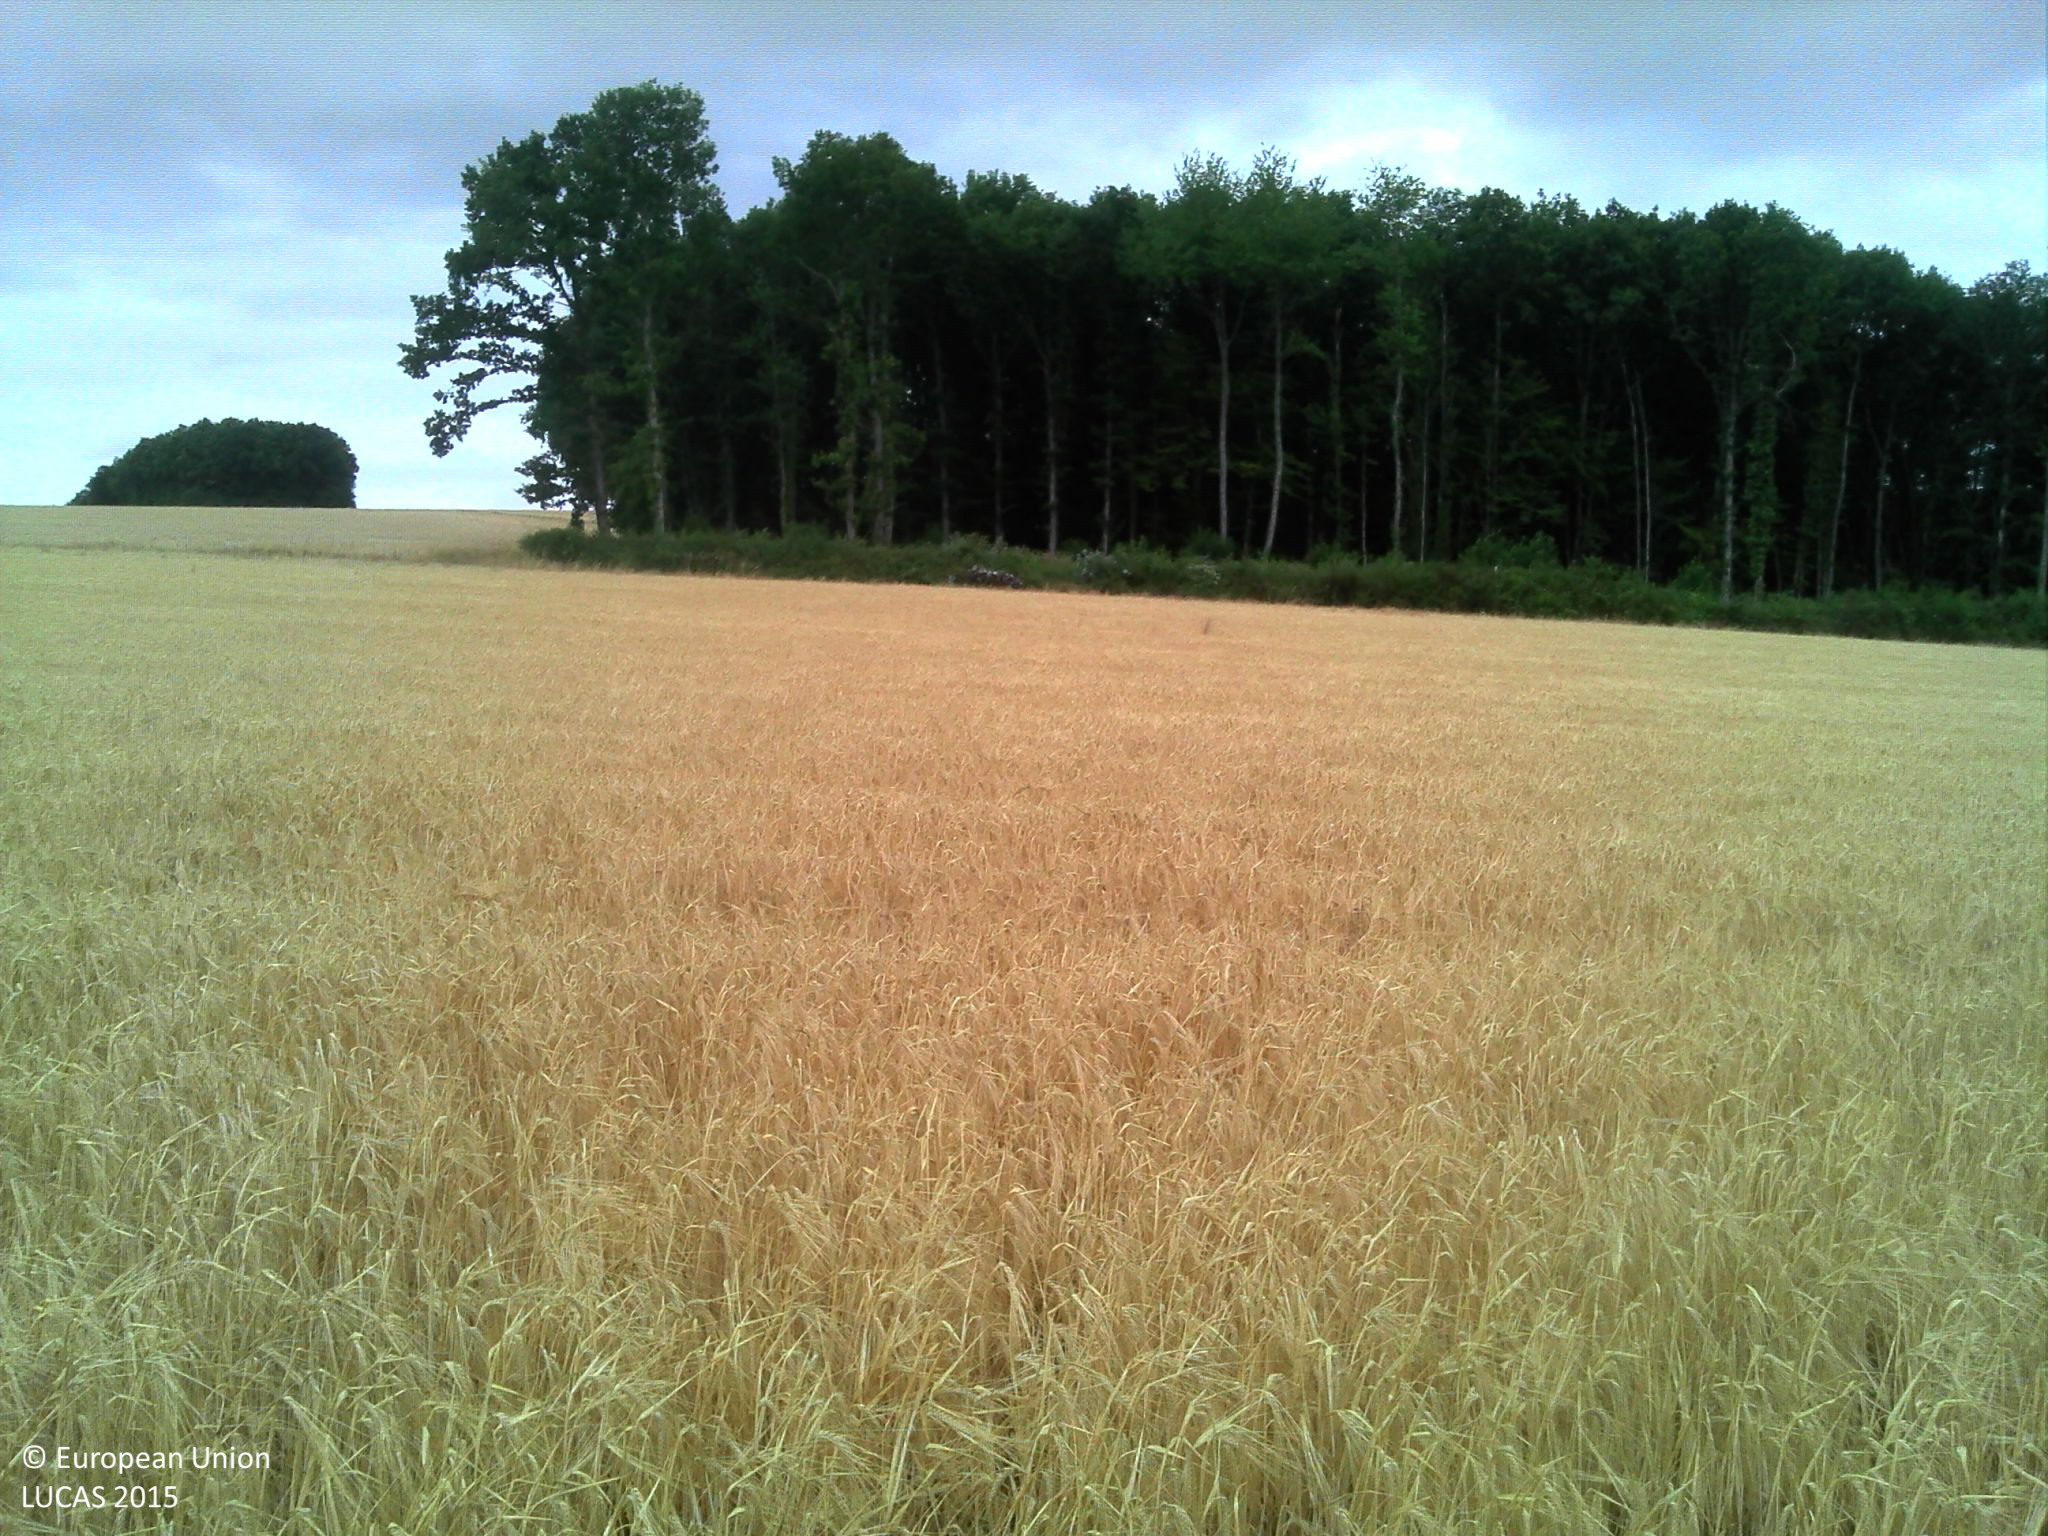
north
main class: Cropland
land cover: Barley
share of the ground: > 75 %
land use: Agriculture (excluding fallow land and kitchen gardens)
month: July
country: FR
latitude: 48.1892
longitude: 3.4163
